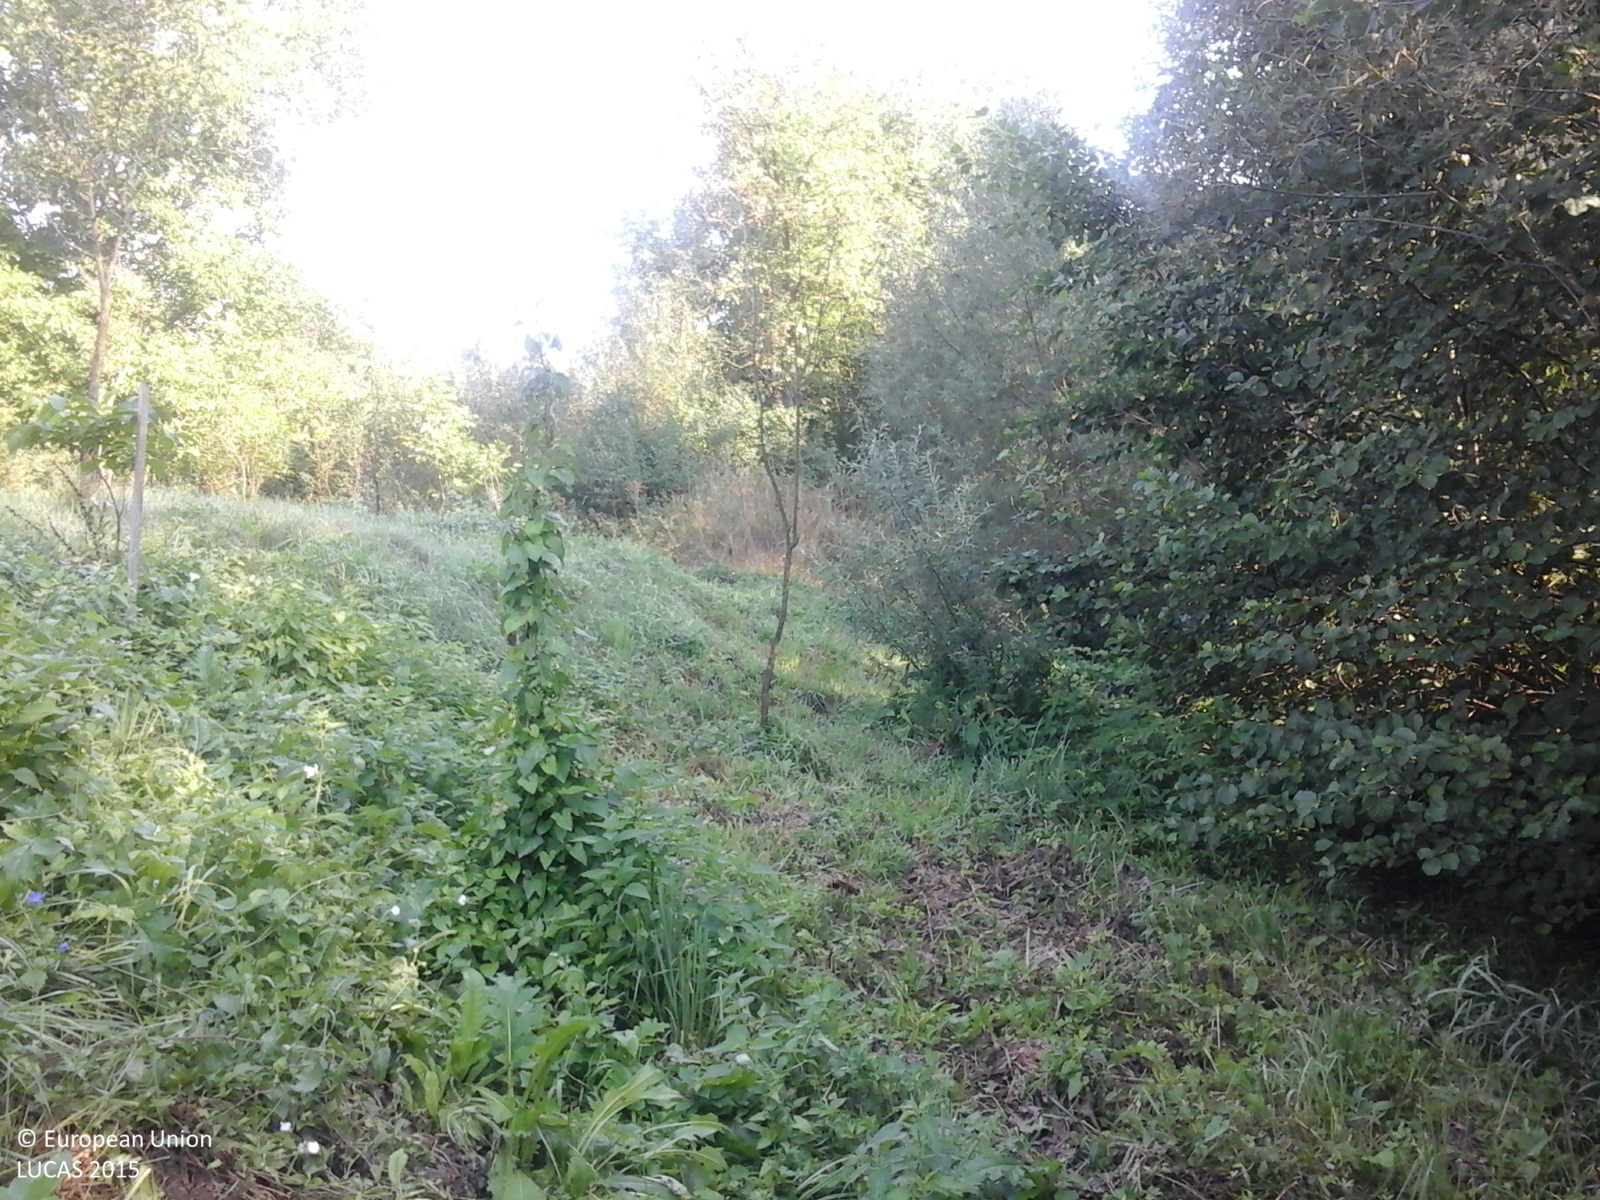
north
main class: Woodland
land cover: Broadleaved woodland
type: broadleaved evergreen forest
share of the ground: > 75 %
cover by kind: broadleaved forest trees 100 %
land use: Forestry
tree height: > 5 m
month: August
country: RO
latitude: 46.2744
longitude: 22.3104
